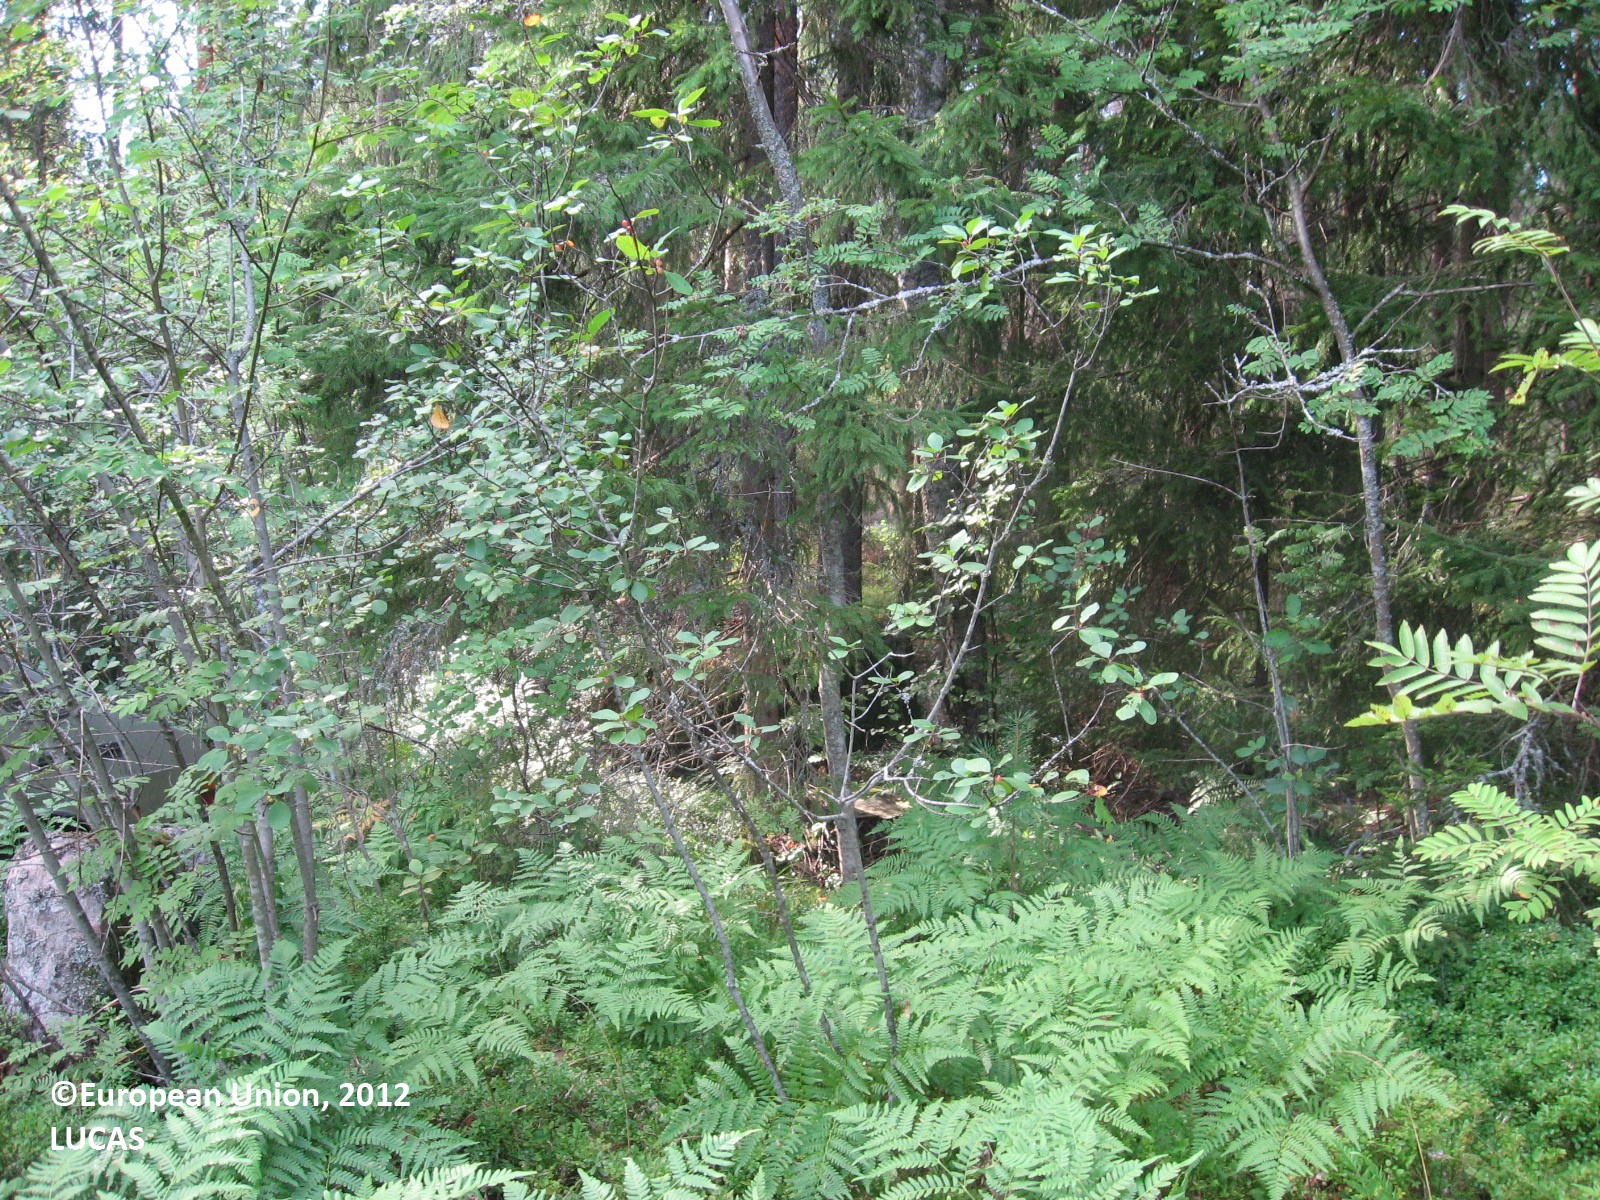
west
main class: Woodland
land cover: Spruce dominated mixed woodland
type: boreal forest
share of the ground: 50 - 75 %
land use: Forestry
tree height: > 5 m
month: August
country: FI
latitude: 60.5959
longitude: 25.4095
